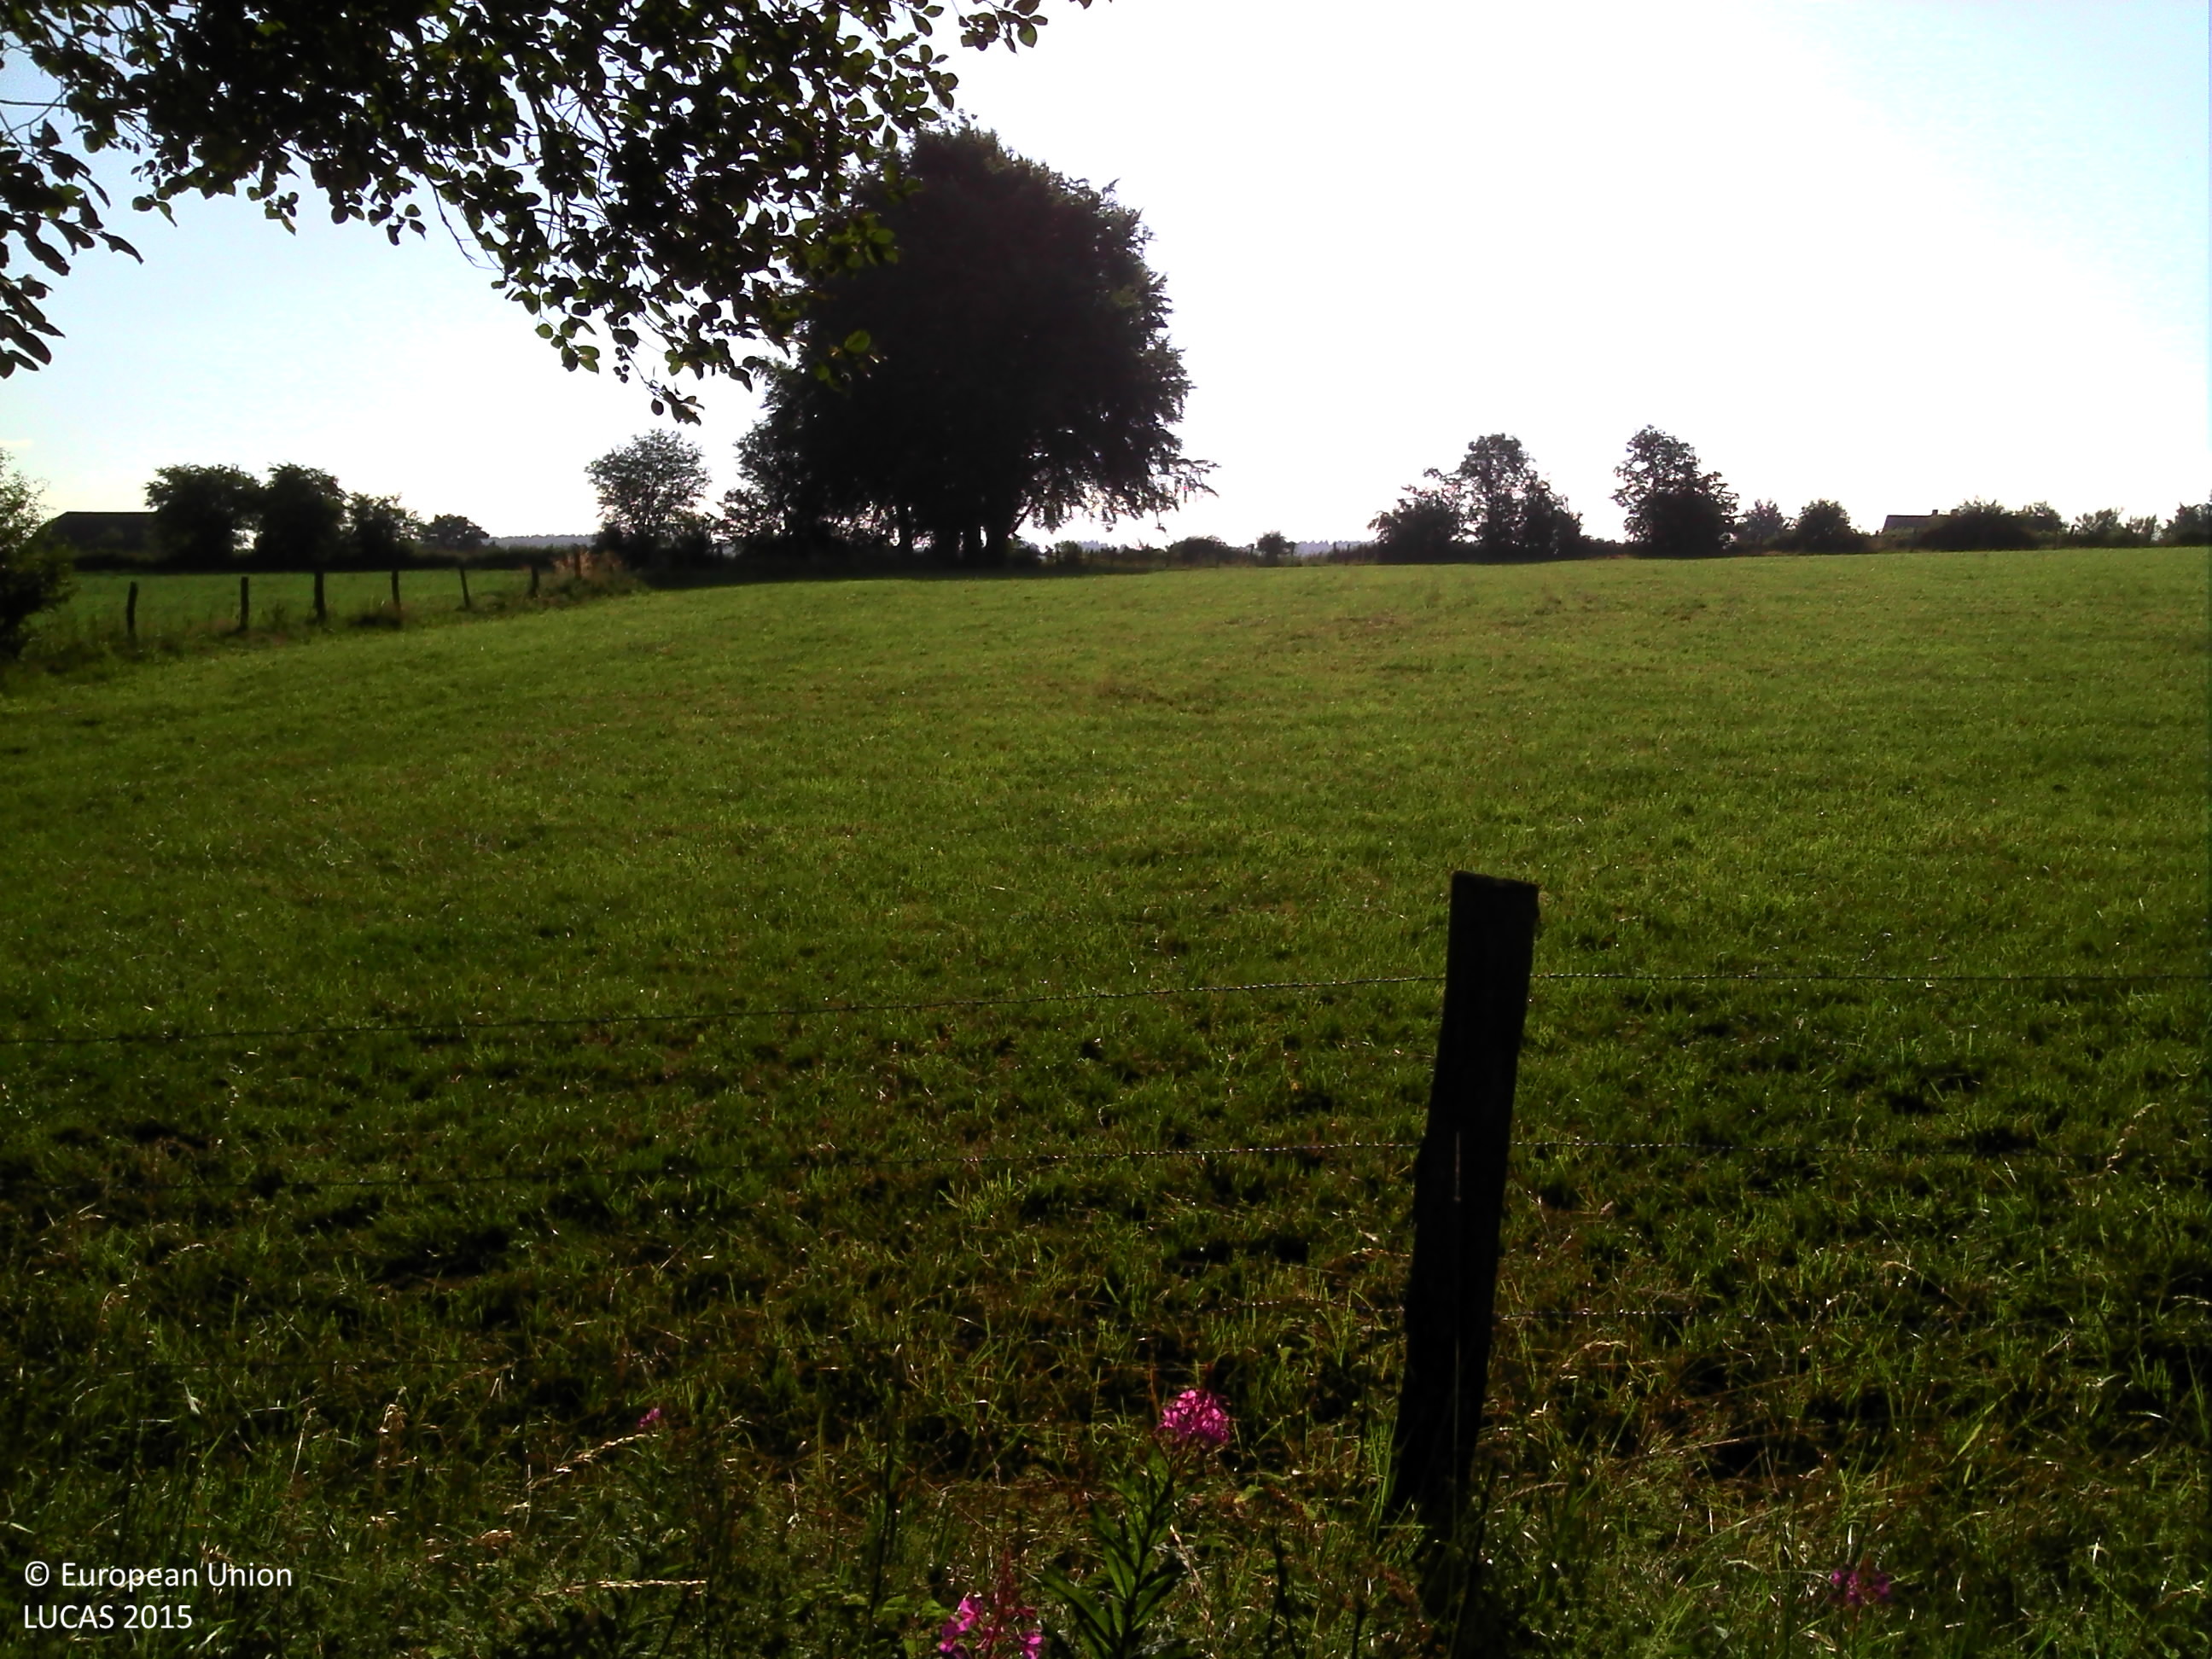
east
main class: Grassland
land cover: Grassland without tree/shrub cover
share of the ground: > 75 %
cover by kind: herbaceous plants 100 %
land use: Agriculture (excluding fallow land and kitchen gardens)
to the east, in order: Grass margins; Grassland without tree/shrub cover; Fences; Tracks; Managed hedges; Fences; Grassland without tree/shrub cover; Fences; Grass margins; Paved roads, cycling and walking lanes
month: July
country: BE
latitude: 50.3735
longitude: 6.2170
